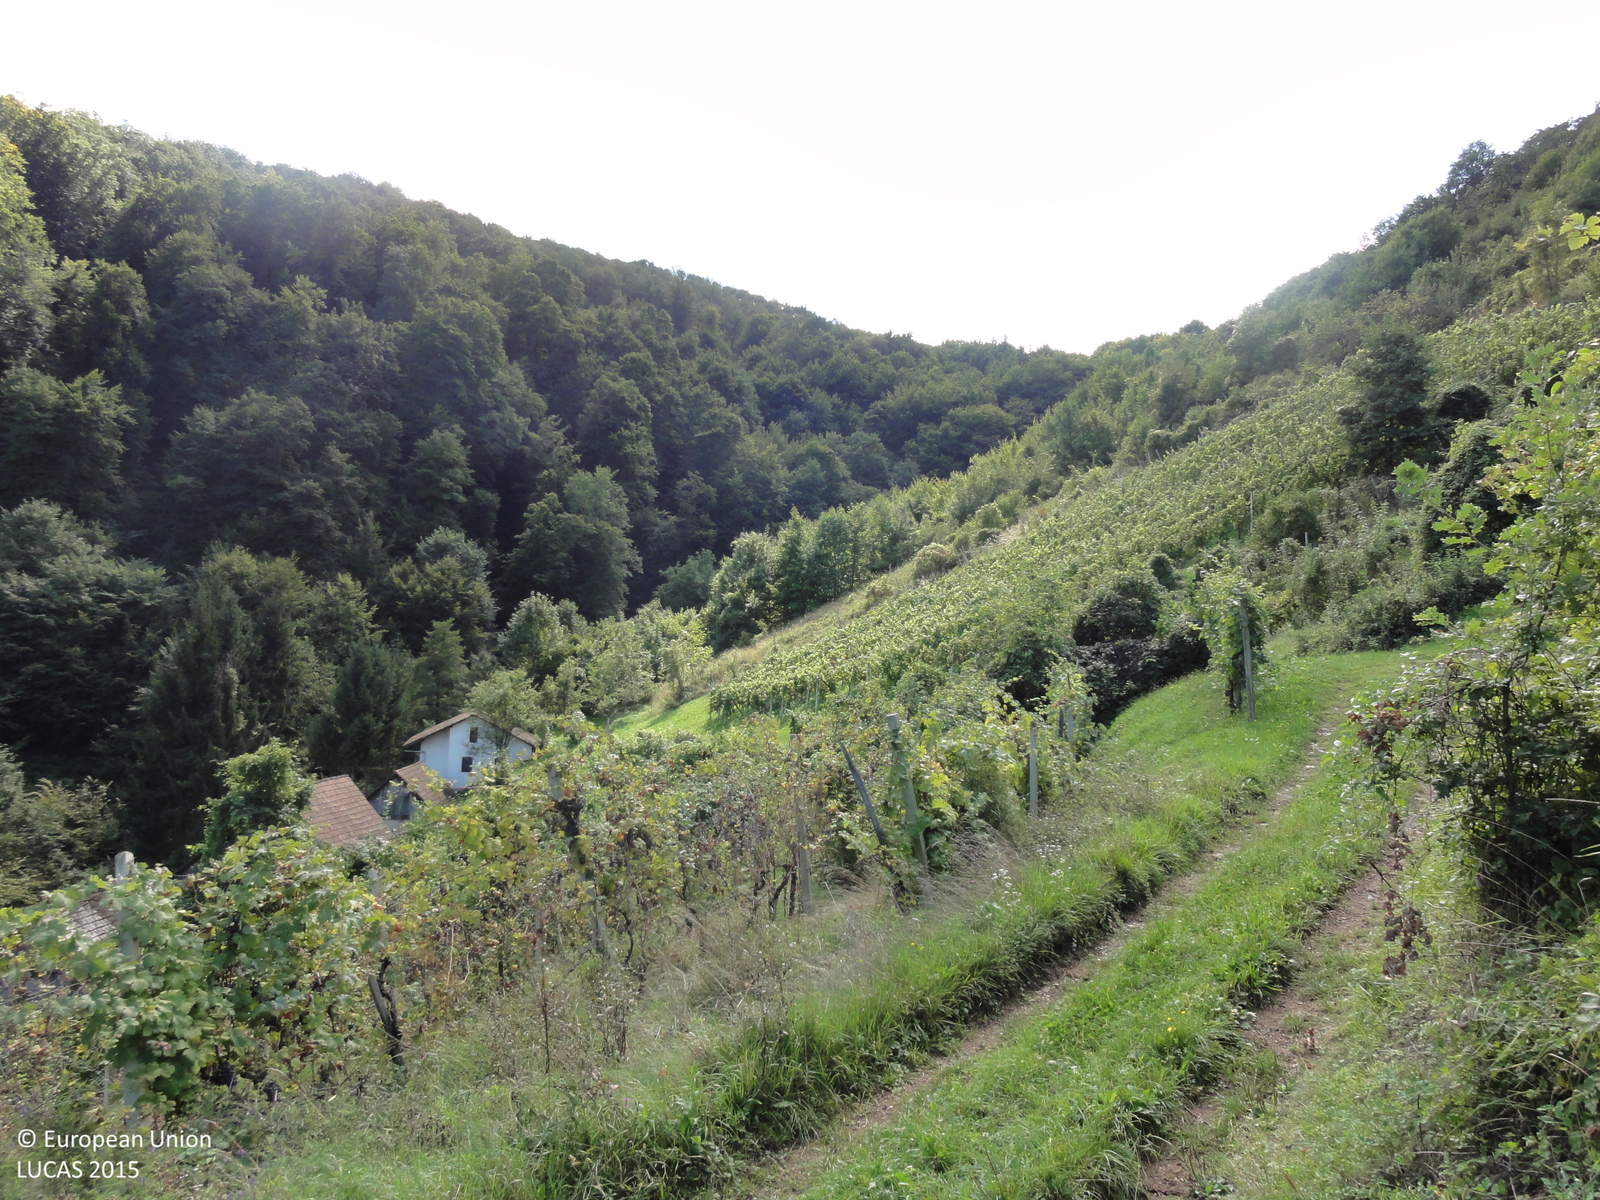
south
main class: Cropland
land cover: Vineyards
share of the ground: 50 - 75 %
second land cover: Grassland without tree/shrub cover
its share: > 75 %
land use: Agriculture (excluding fallow land and kitchen gardens)
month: September
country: SI
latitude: 45.8502
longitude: 15.4701
